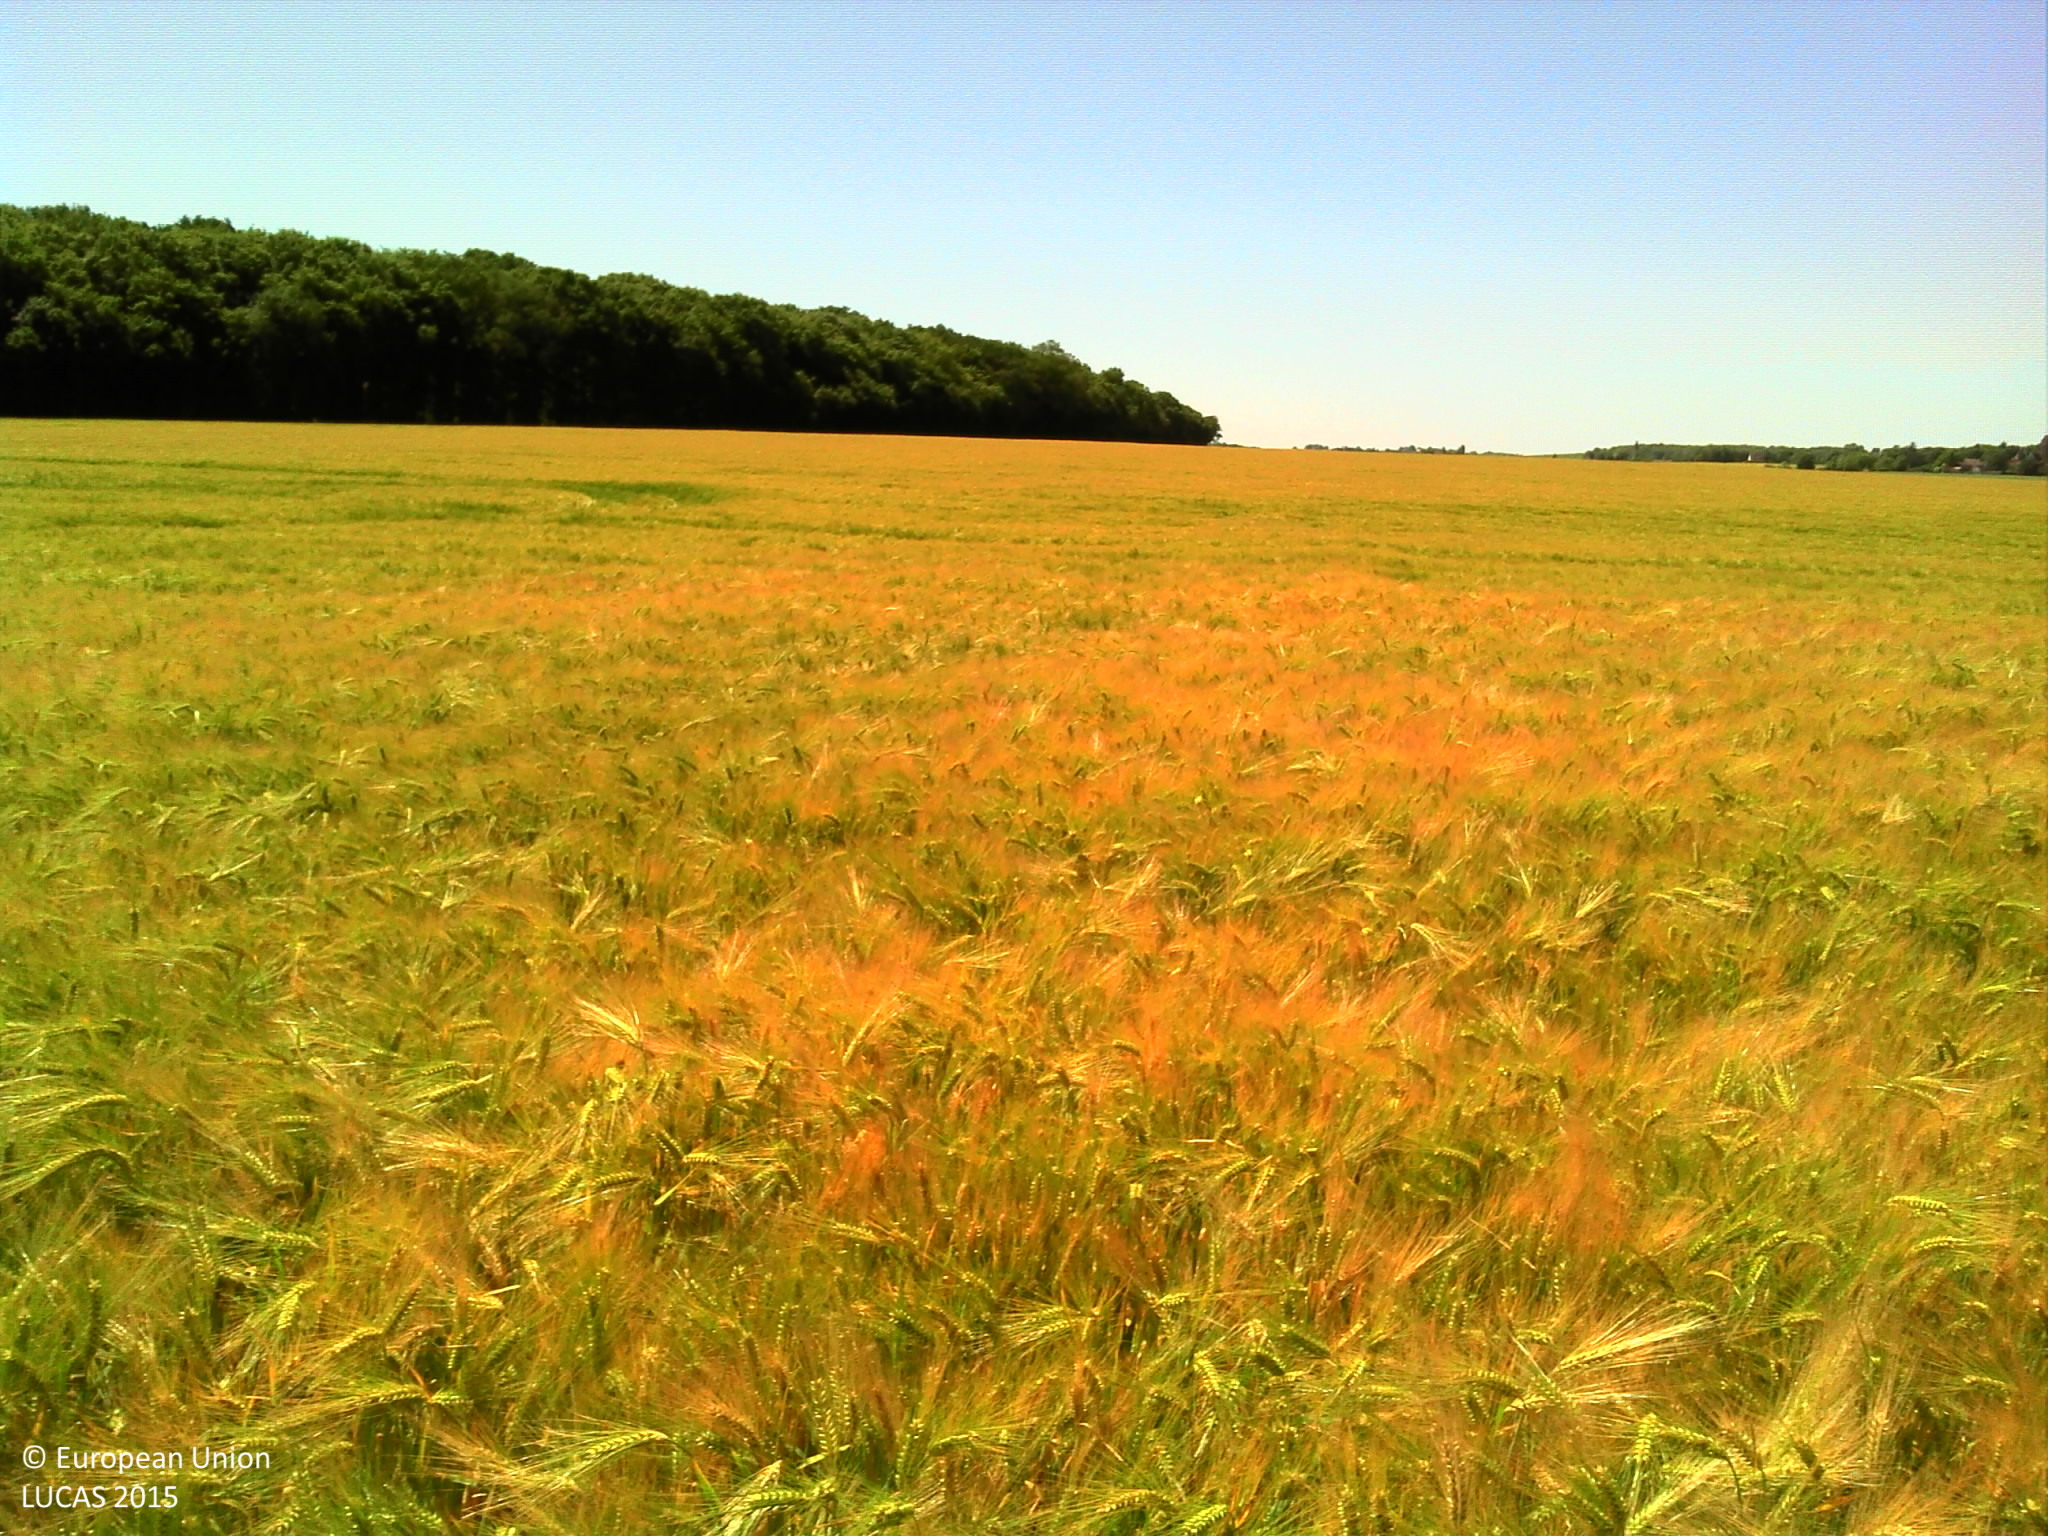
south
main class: Cropland
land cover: Barley
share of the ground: > 75 %
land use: Agriculture (excluding fallow land and kitchen gardens)
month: June
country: FR
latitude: 47.0567
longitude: 2.9256
